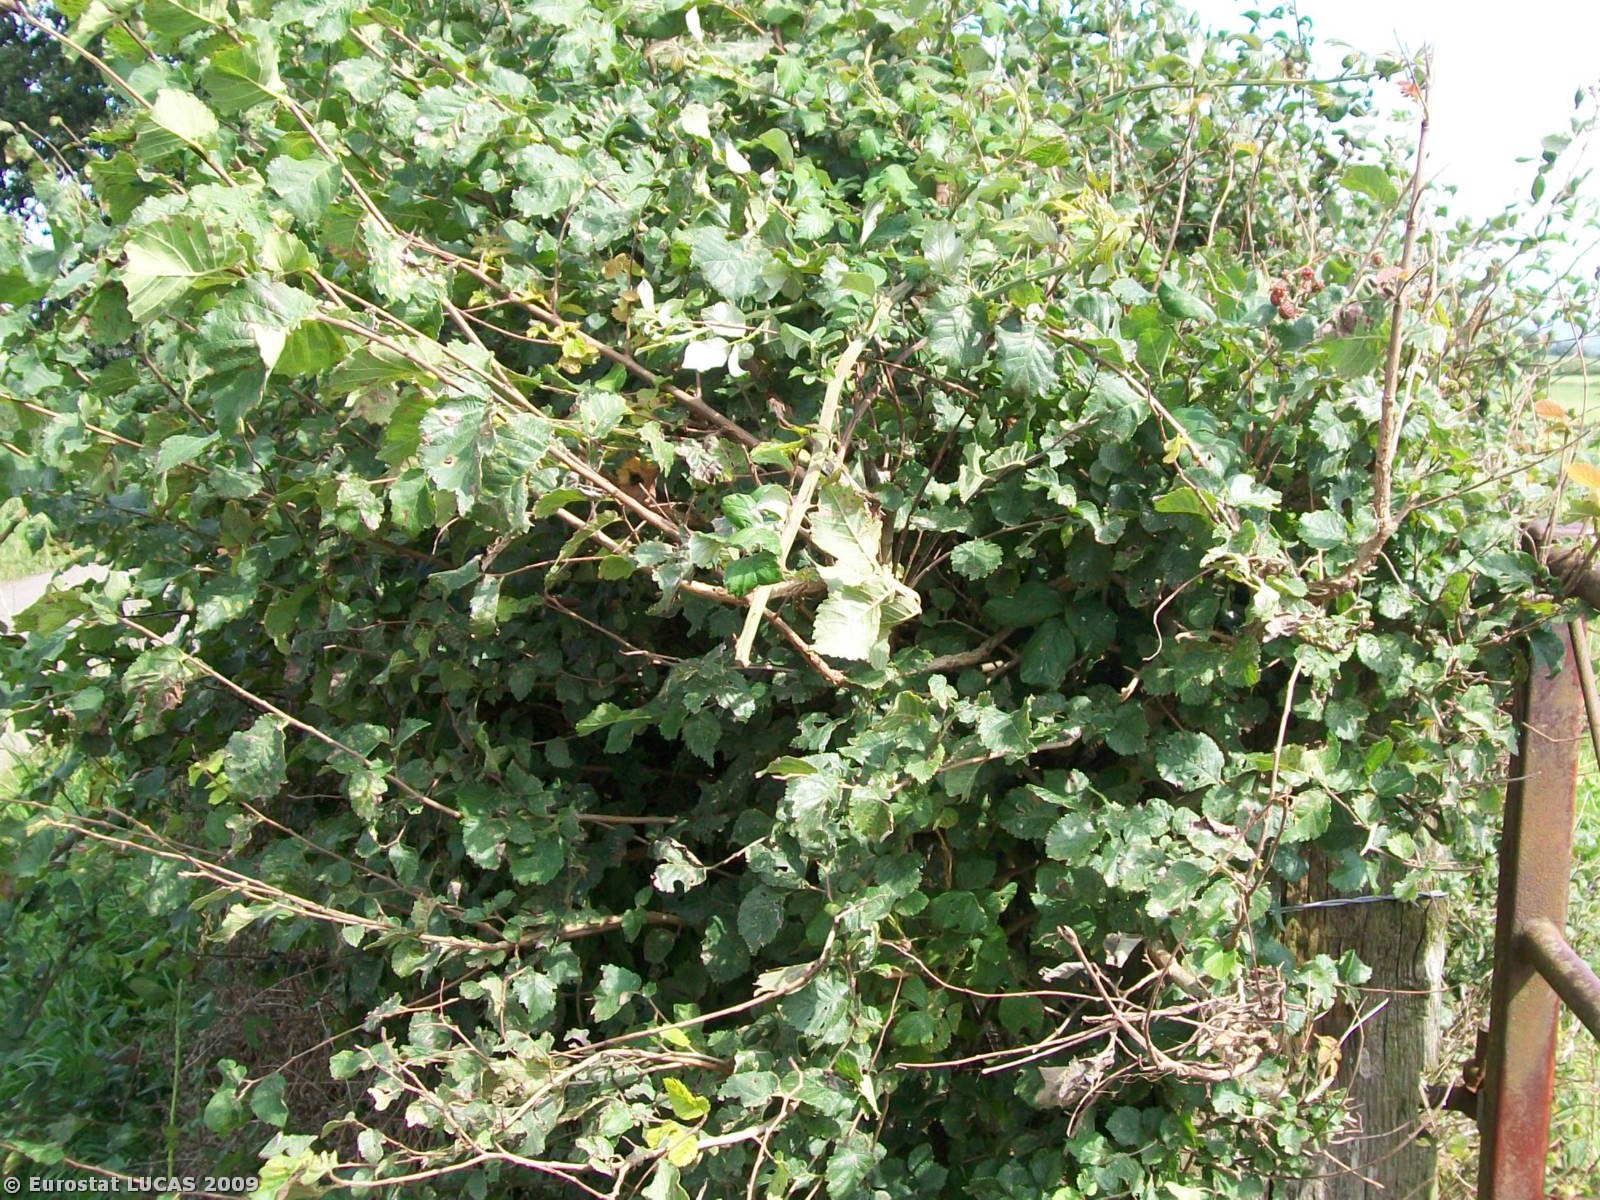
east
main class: Grassland
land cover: Grassland without tree/shrub cover
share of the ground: > 75 %
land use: Agriculture (excluding fallow land and kitchen gardens)
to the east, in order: Grassland without tree/shrub cover; Managed hedges; Rye
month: August
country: GB
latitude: 51.8526
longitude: -2.3905
